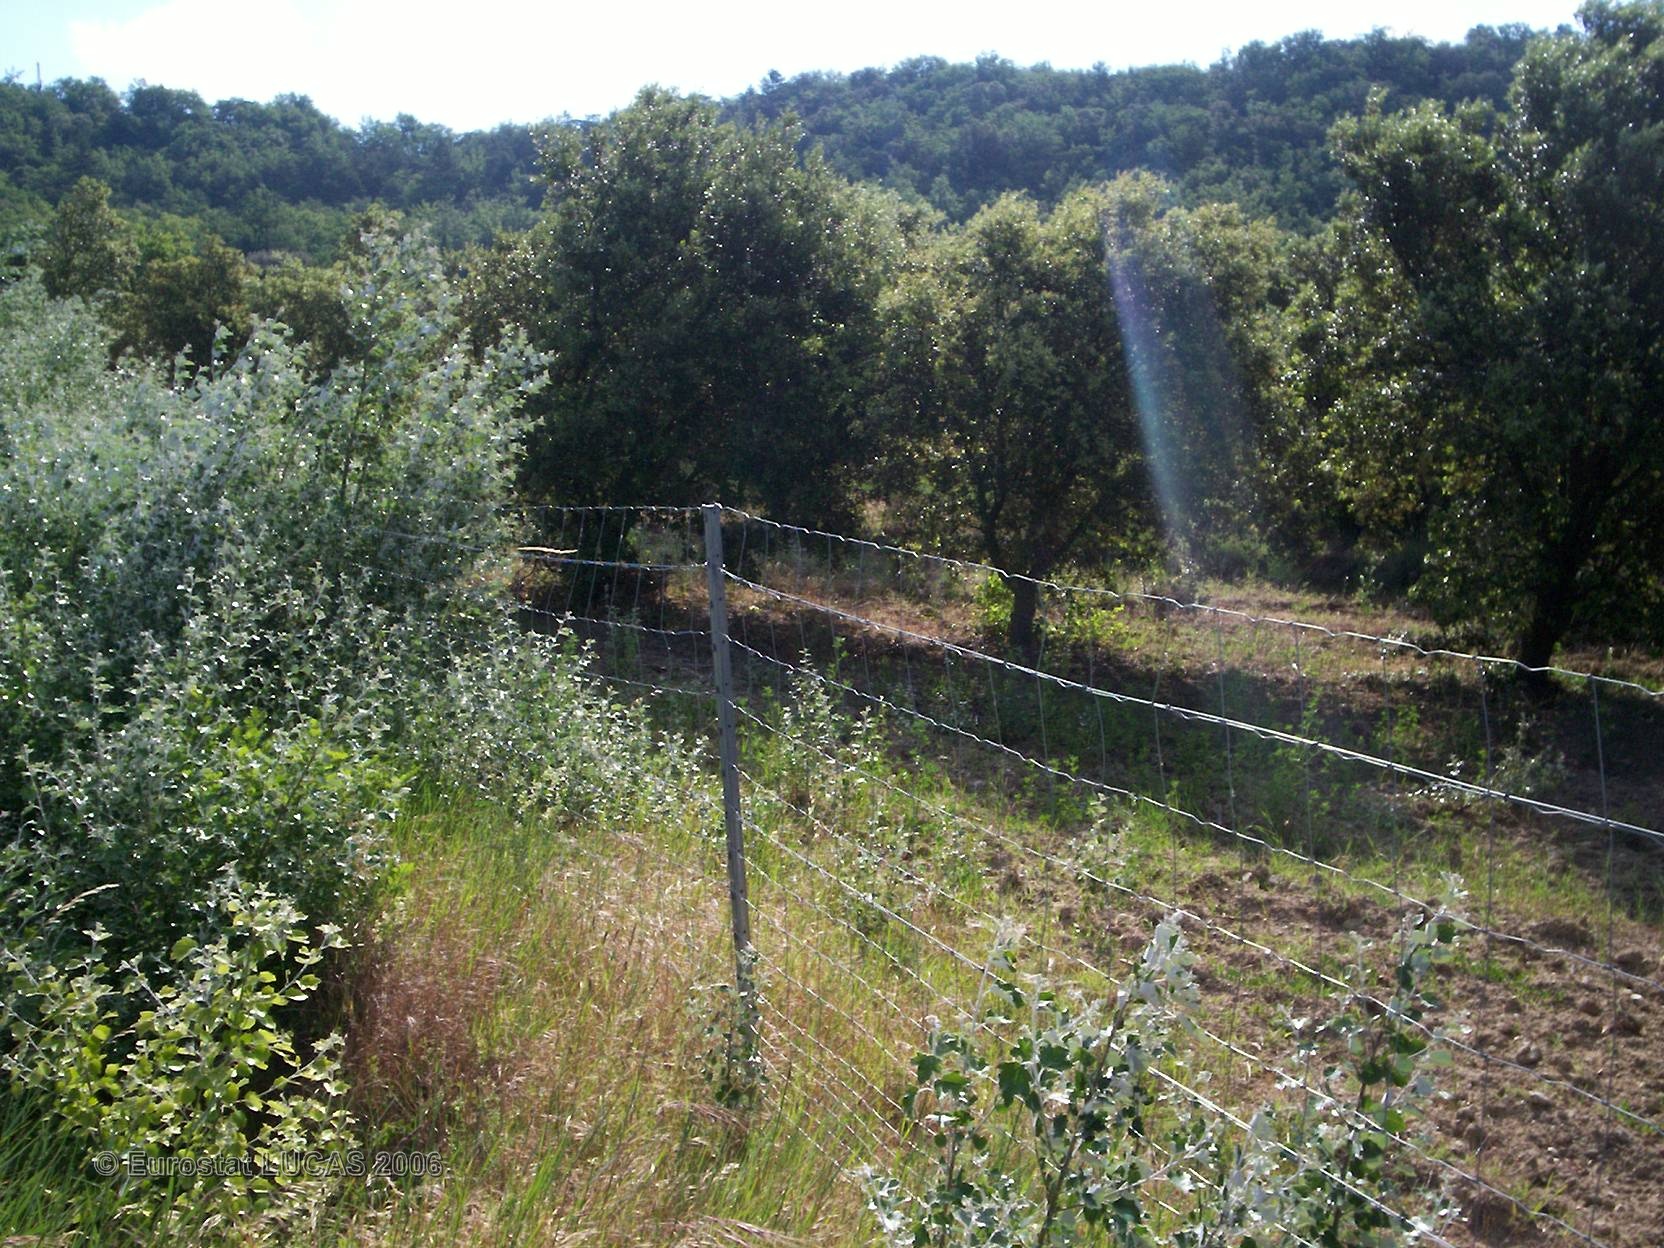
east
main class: Woodland
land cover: Broadleaved forest
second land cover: Permanent industrial crops
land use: Agriculture (excluding fallow land and kitchen gardens)
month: June
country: FR
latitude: 44.4249
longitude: 4.9200
